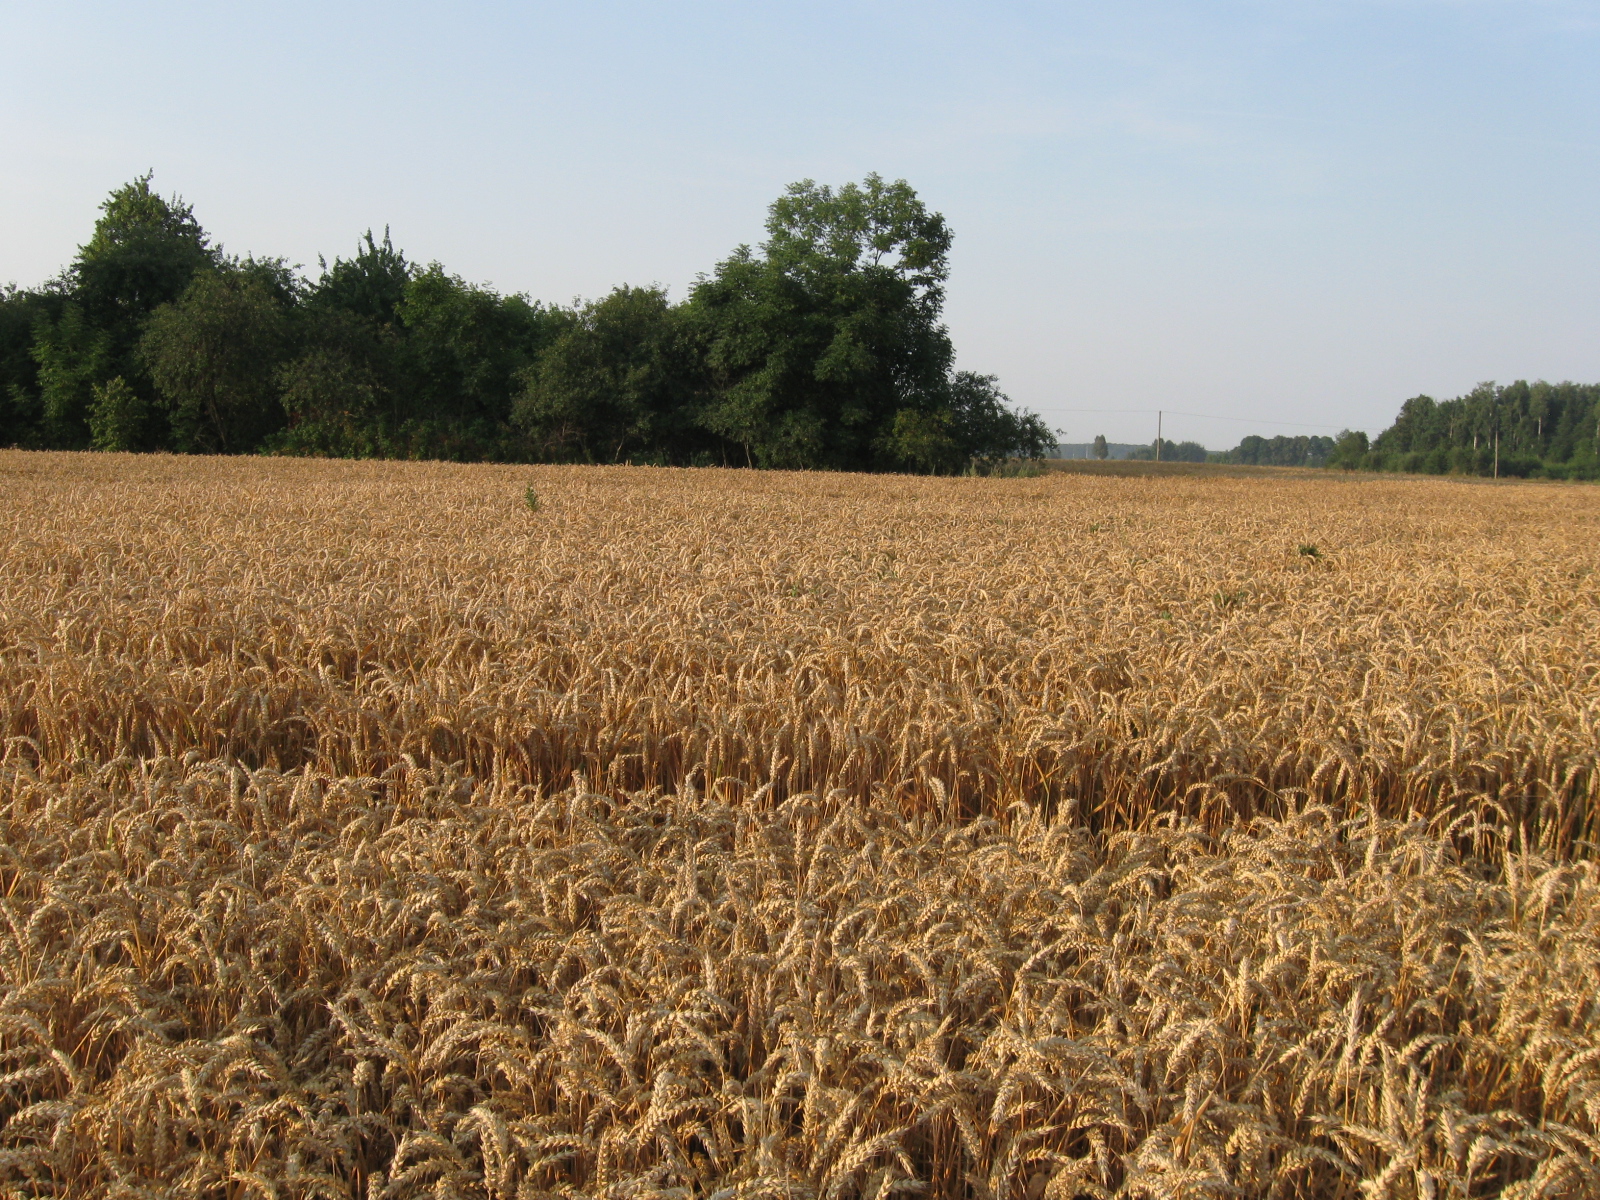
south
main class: Cropland
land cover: Common wheat
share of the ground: > 75 %
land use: Agriculture (excluding fallow land and kitchen gardens)
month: August
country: LT
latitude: 54.6169
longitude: 23.2868
